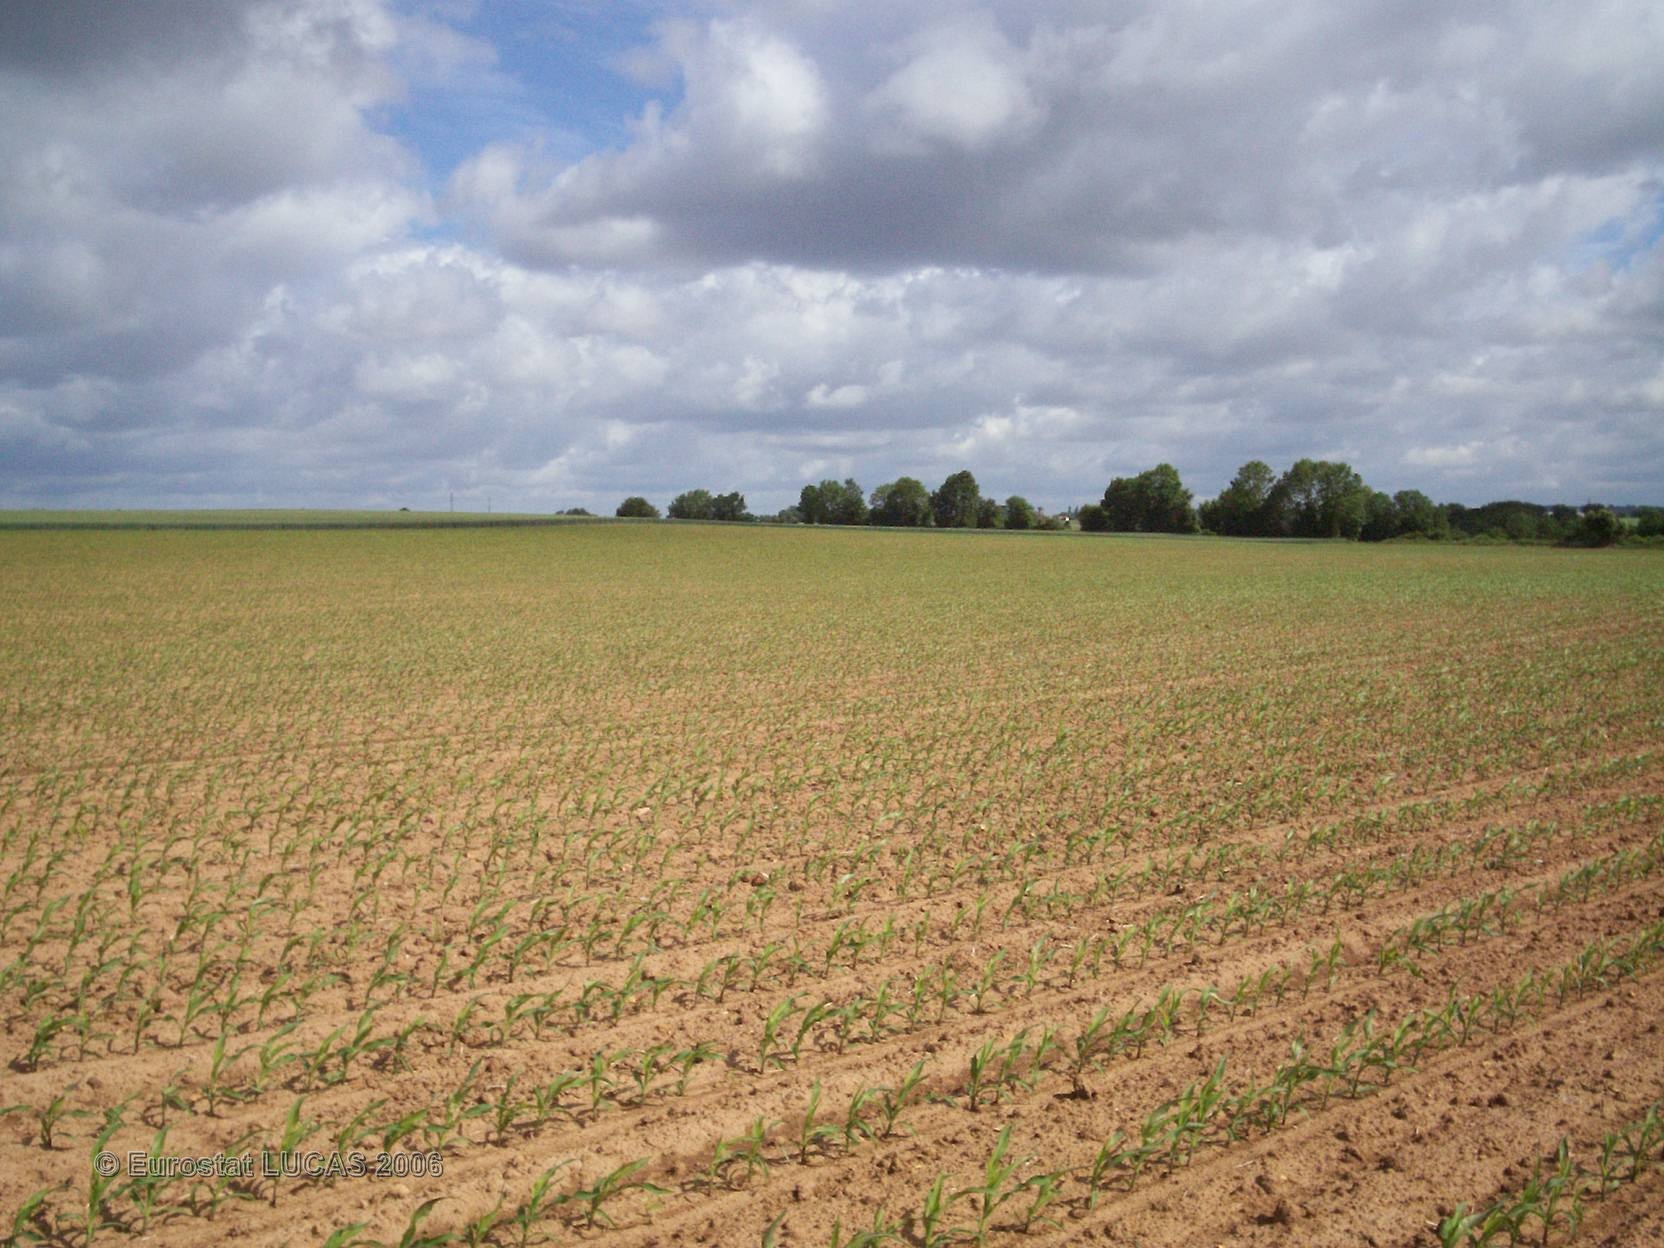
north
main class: Cropland
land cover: Maize
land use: Agriculture (excluding fallow land and kitchen gardens)
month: May
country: FR
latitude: 46.2075
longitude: -0.1965
